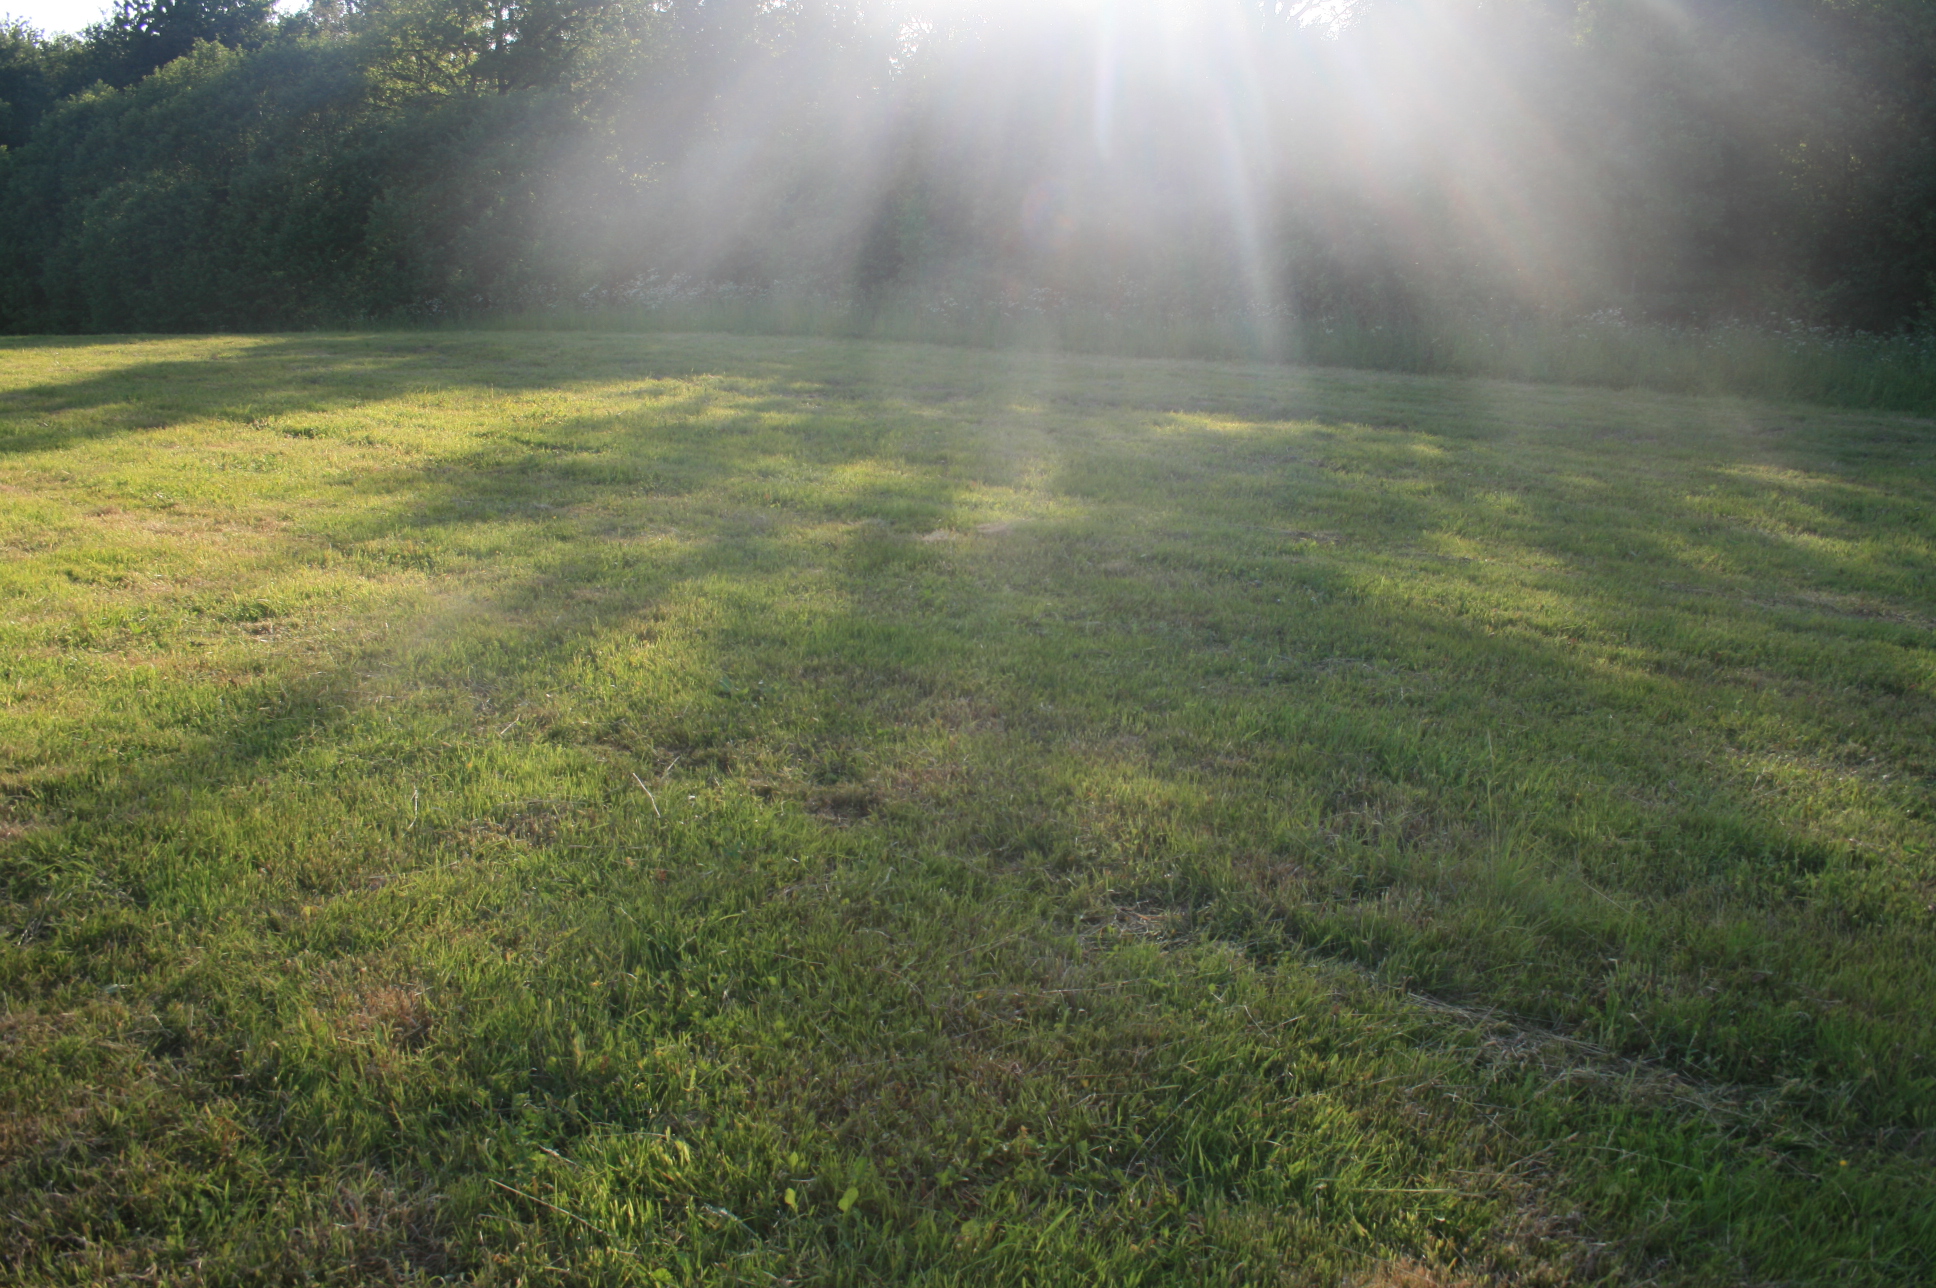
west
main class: Grassland
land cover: Grassland without tree/shrub cover
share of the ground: > 75 %
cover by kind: herbaceous plants 100 %
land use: Agriculture (excluding fallow land and kitchen gardens)
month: June
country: LT
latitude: 55.5678
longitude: 22.1871
